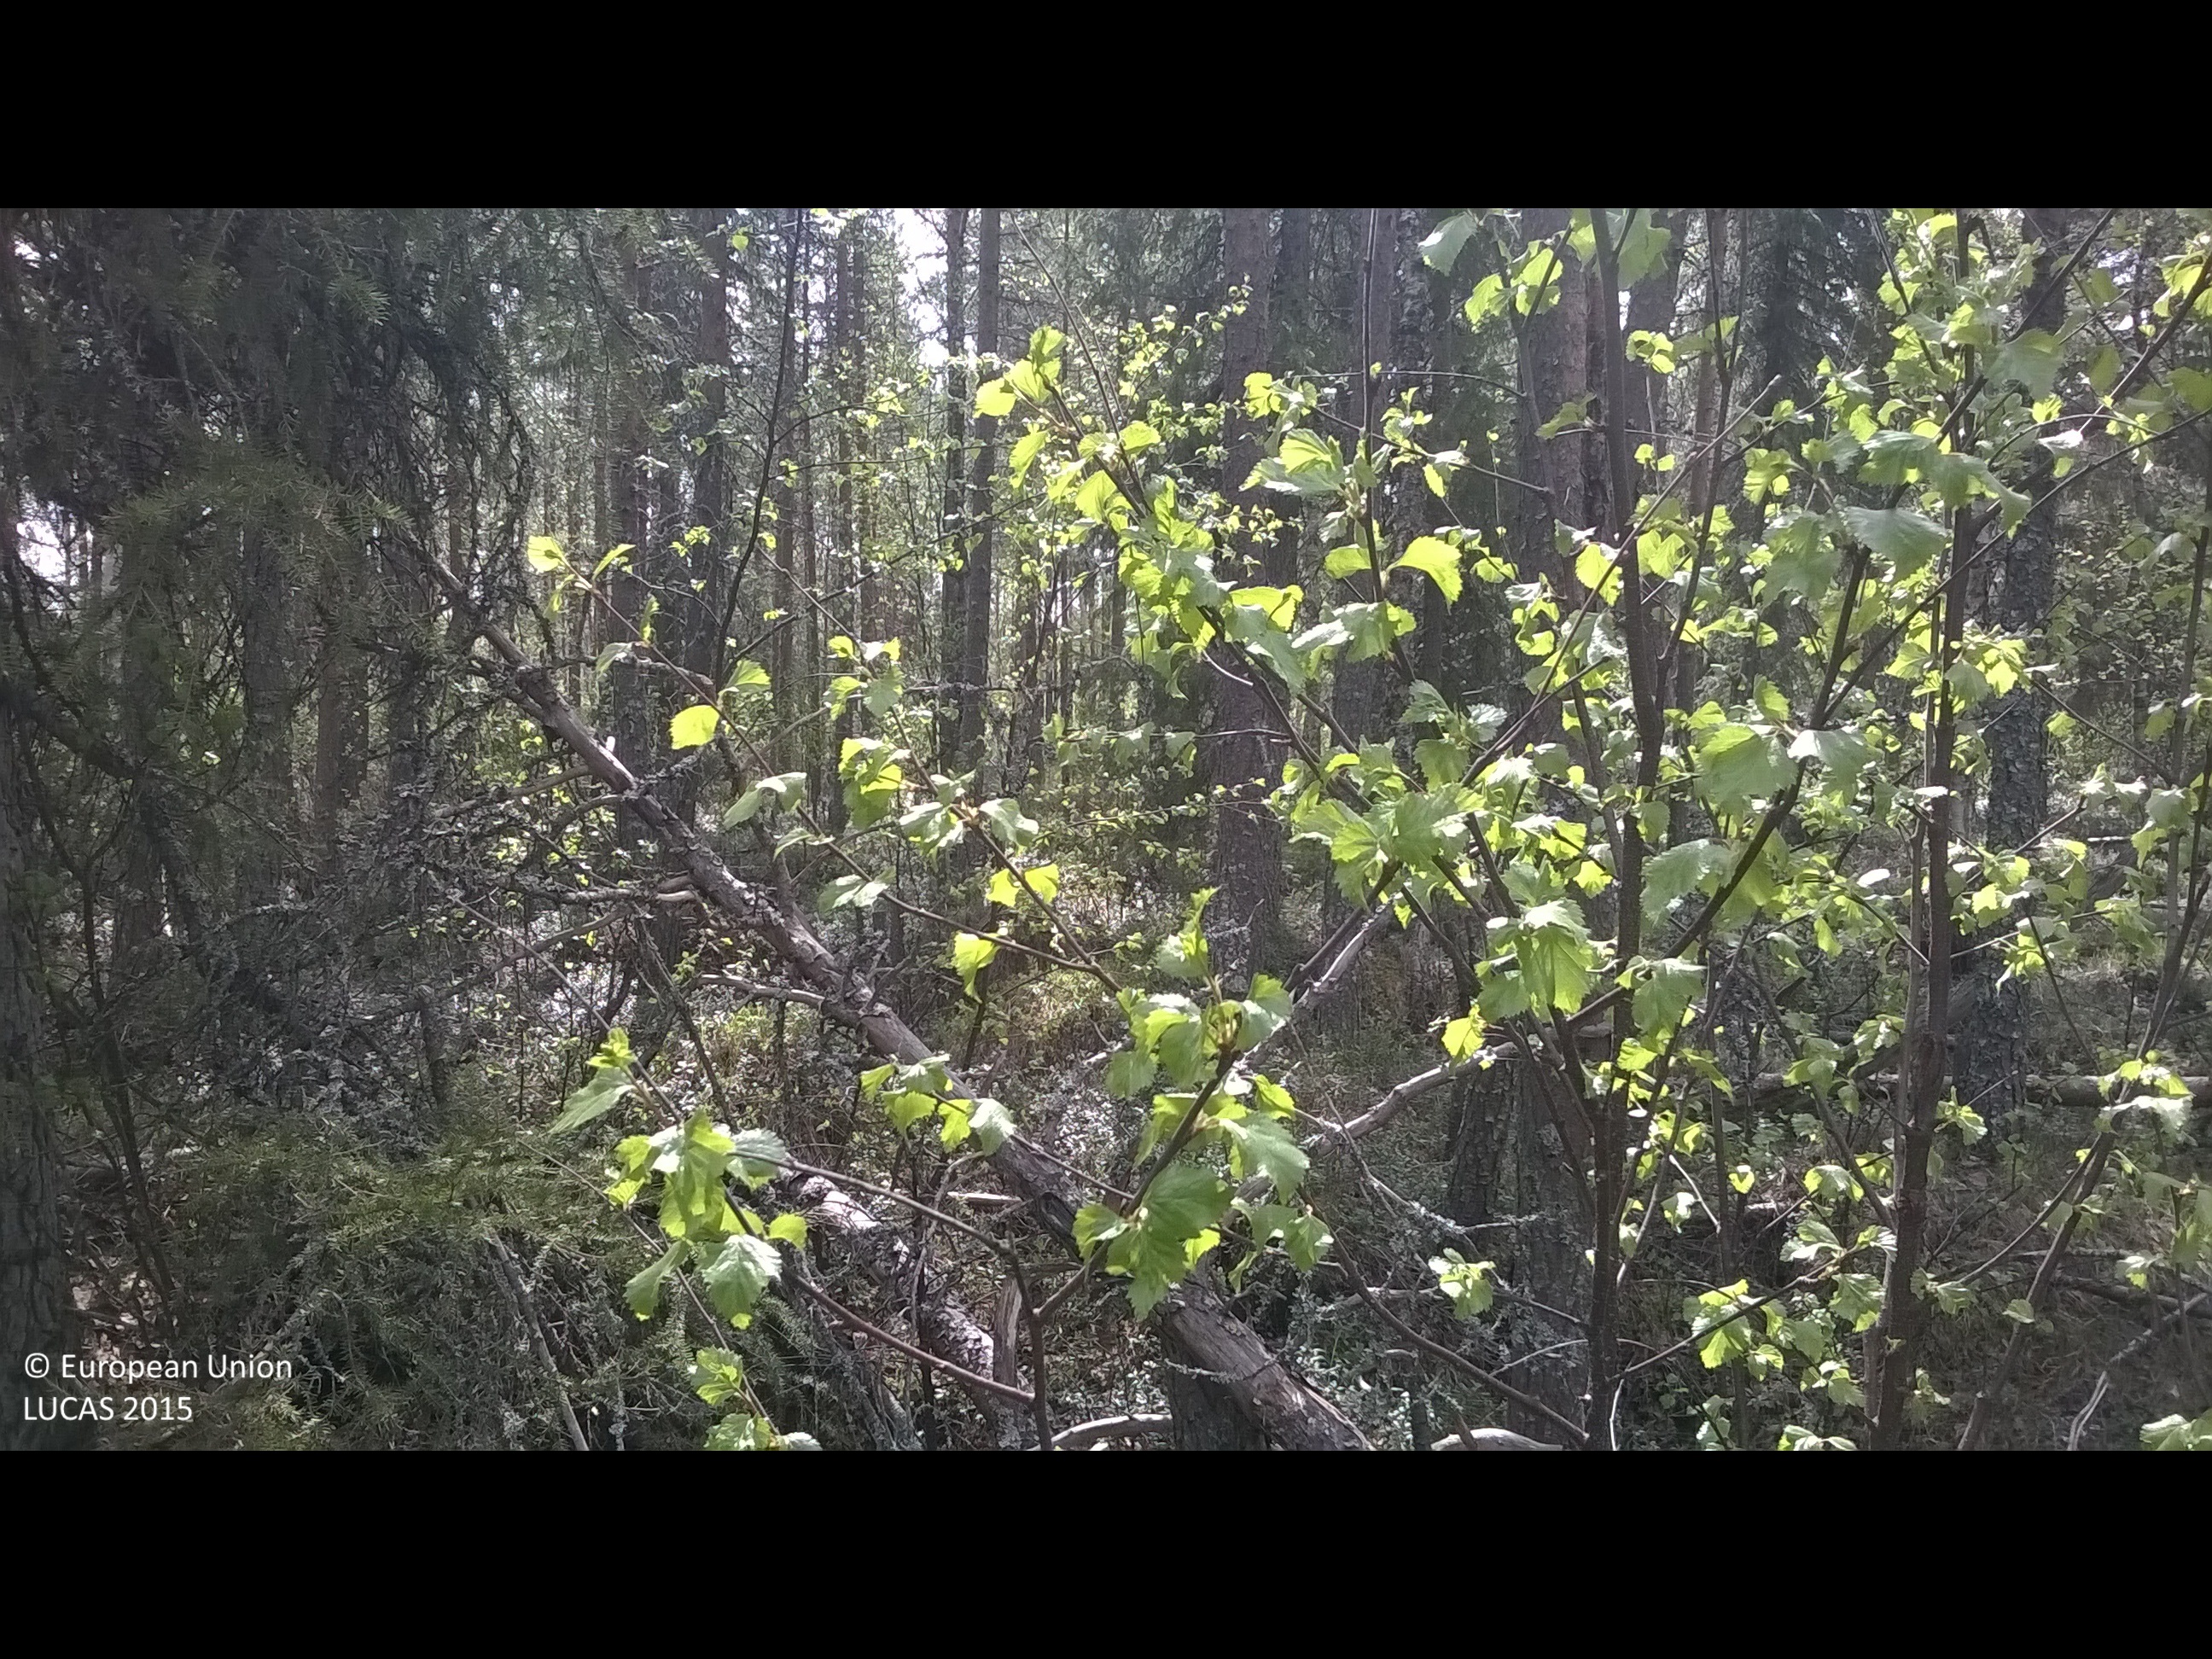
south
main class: Woodland
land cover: Pine dominated mixed woodland
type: boreal forest
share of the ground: > 75 %
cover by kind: broadleaved forest trees 60 %, coniferous forest trees 35 %, shrubs 5 %
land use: Forestry
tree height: > 5 m
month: June
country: FI
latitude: 66.5738
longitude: 26.4723
